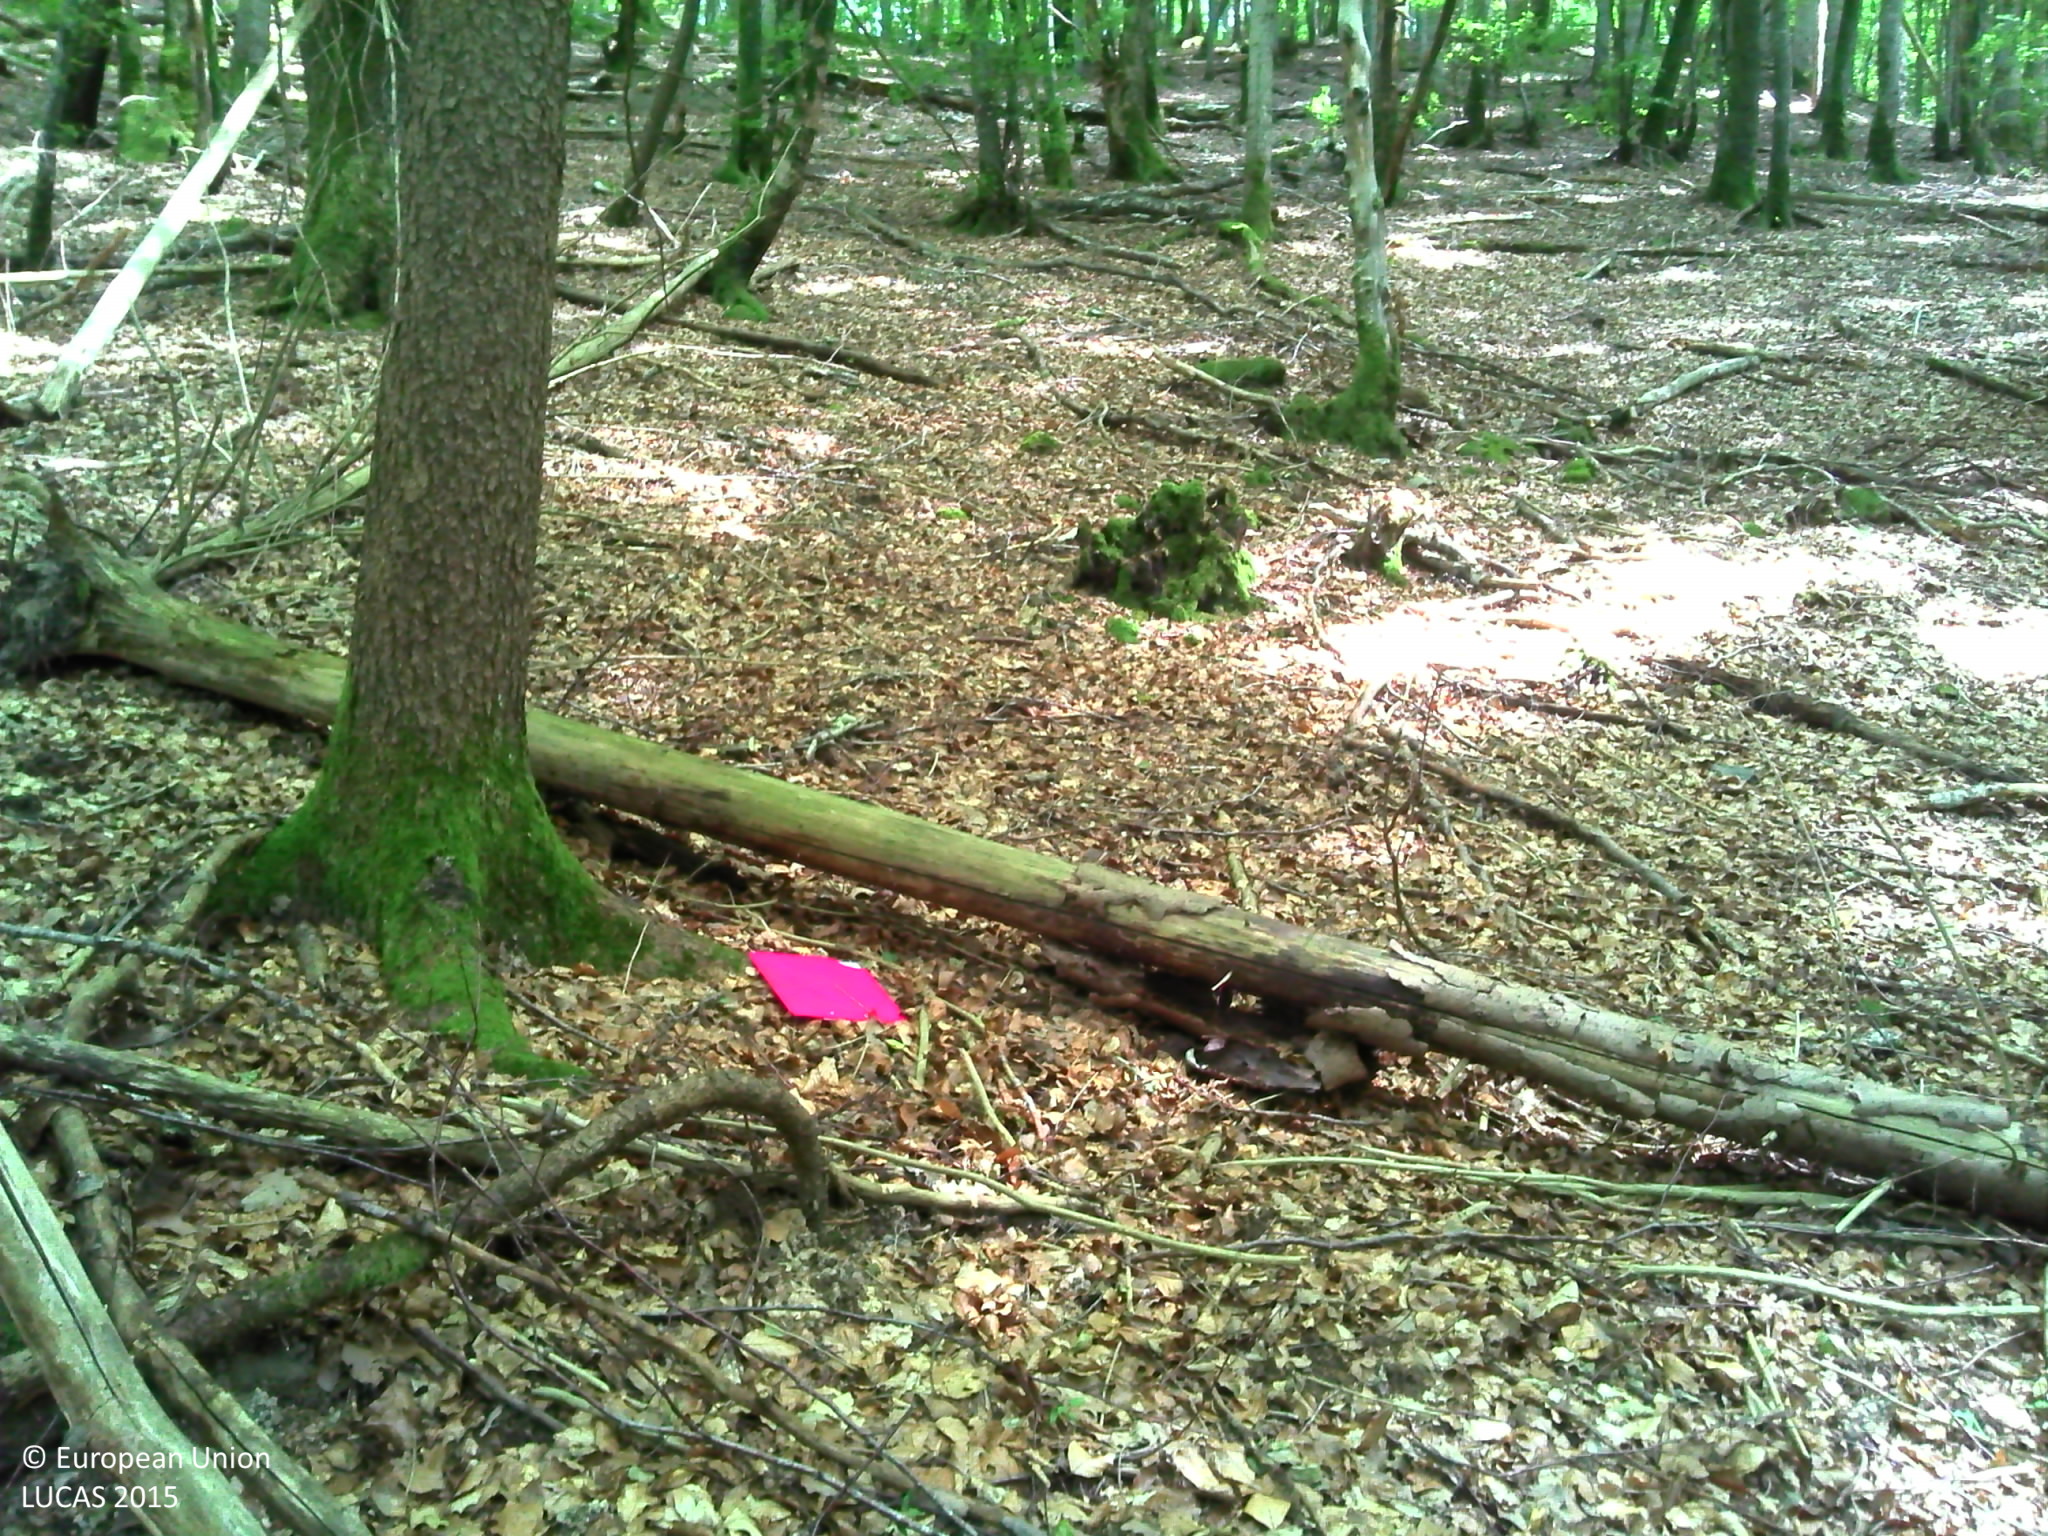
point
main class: Woodland
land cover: Broadleaved woodland
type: beech forest
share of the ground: > 75 %
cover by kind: broadleaved forest trees 75 %, coniferous forest trees 15 %, herbaceous plants 5 %, lichens and mosses 5 %
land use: Forestry
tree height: > 5 m
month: July
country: FR
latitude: 46.1307
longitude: 6.4701
